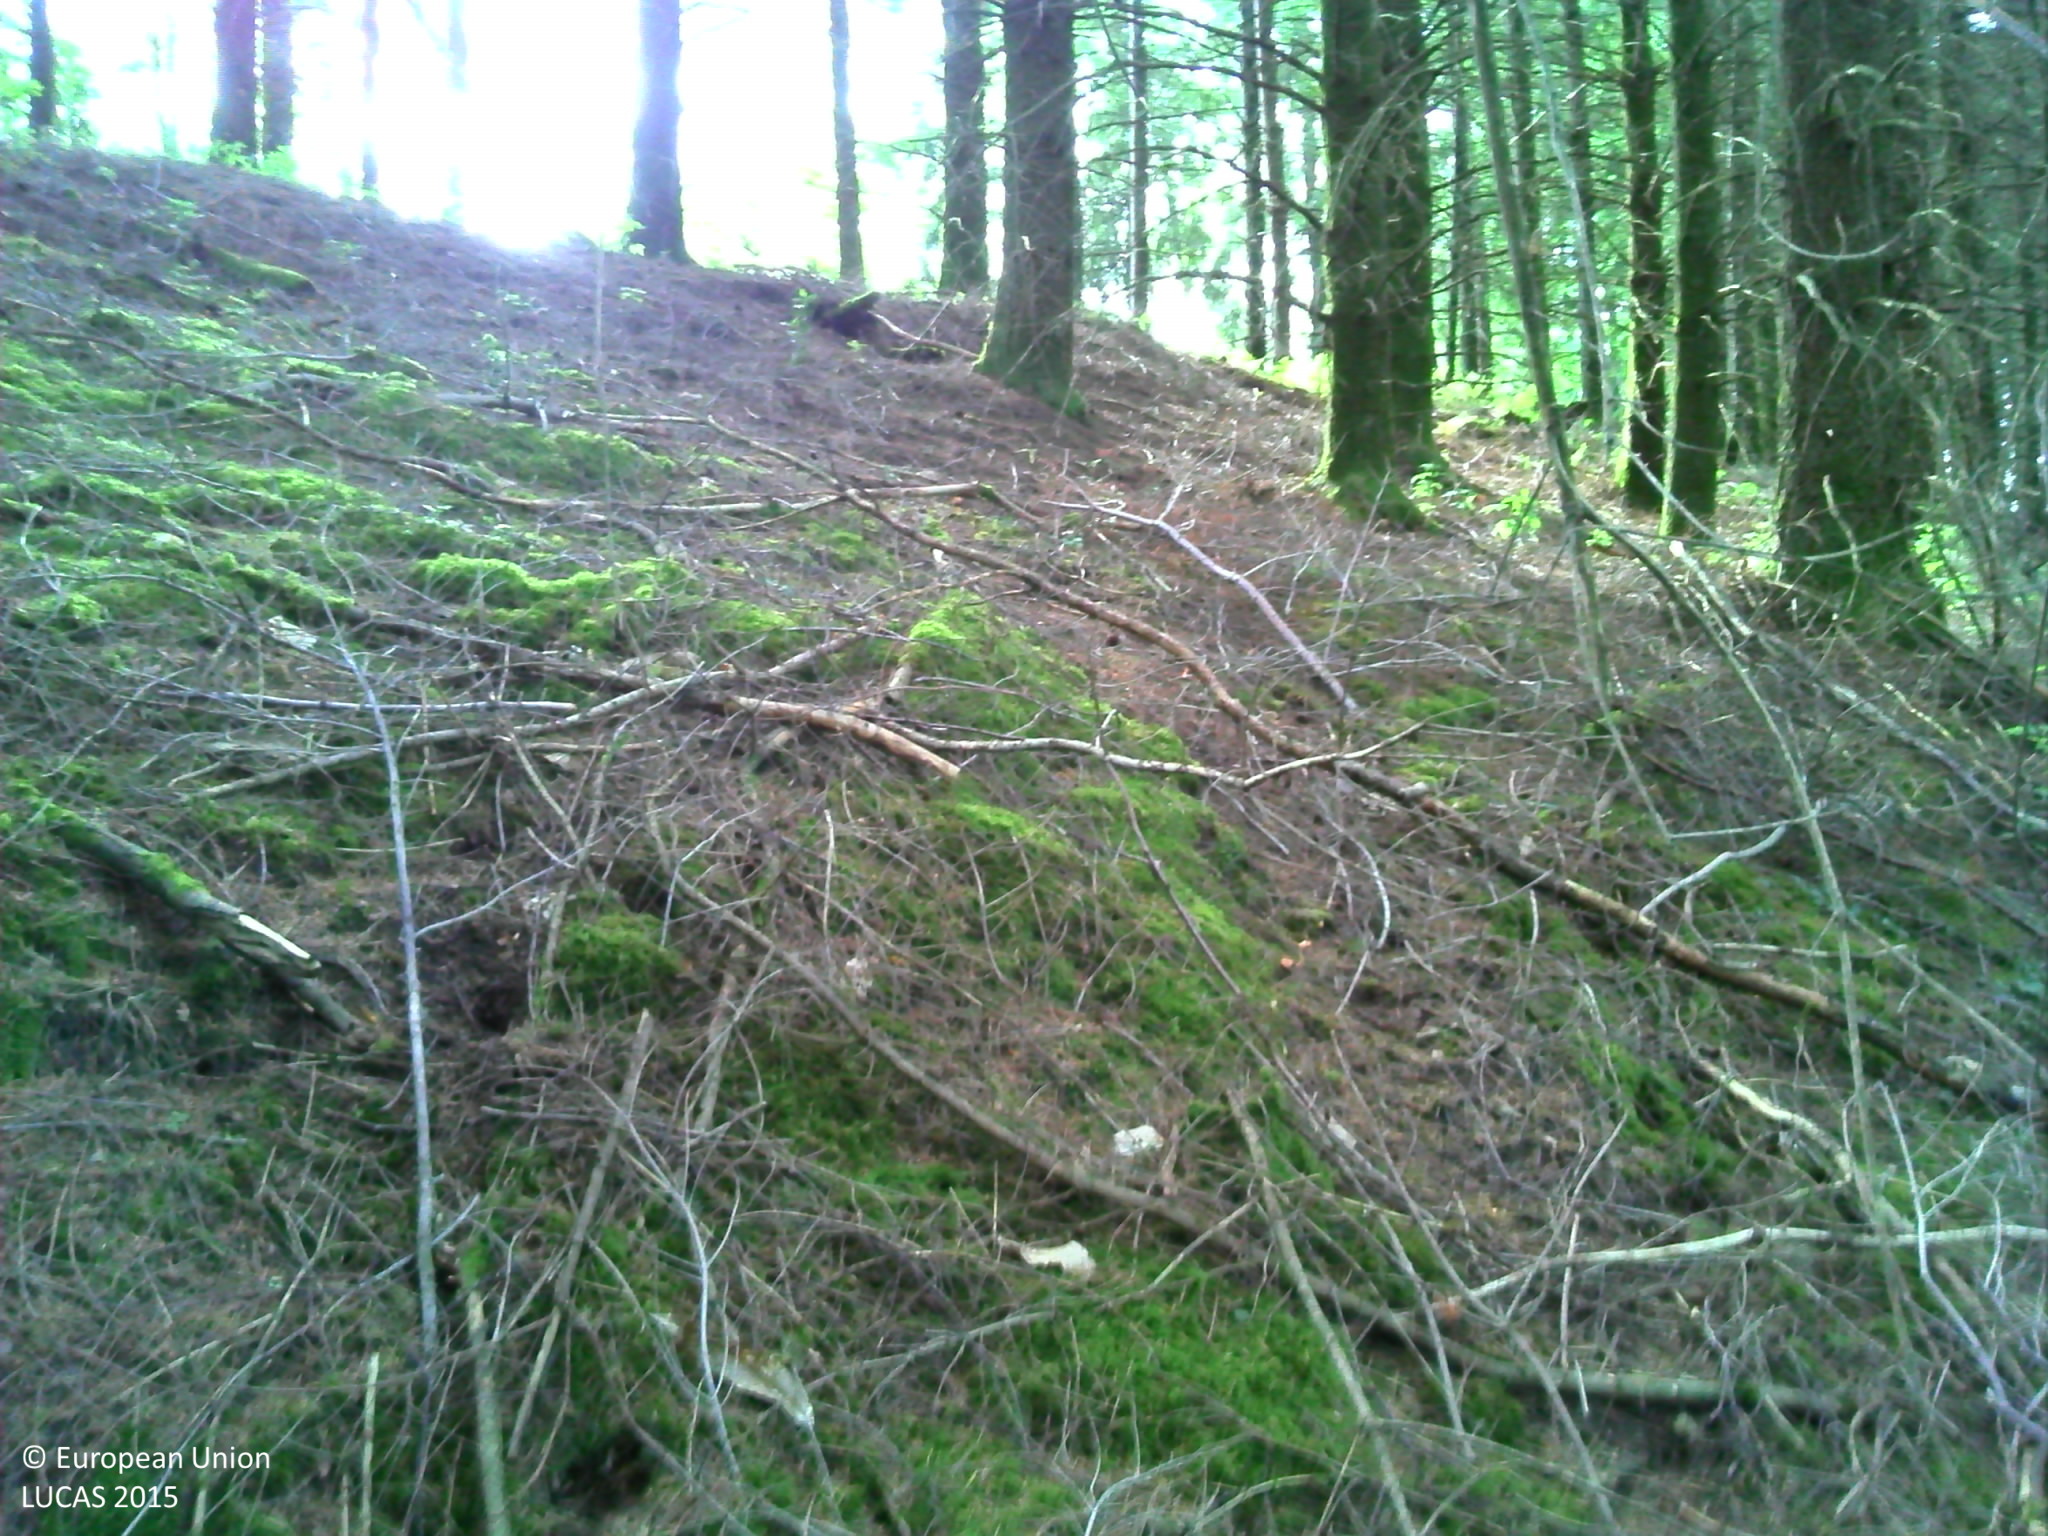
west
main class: Woodland
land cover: Spruce dominated coniferous woodland
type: exotic forest
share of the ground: > 75 %
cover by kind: coniferous forest trees 70 %, lichens and mosses 20 %, herbaceous plants 10 %
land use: Forestry
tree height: > 5 m
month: July
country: FR
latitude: 45.6514
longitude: 1.7433
